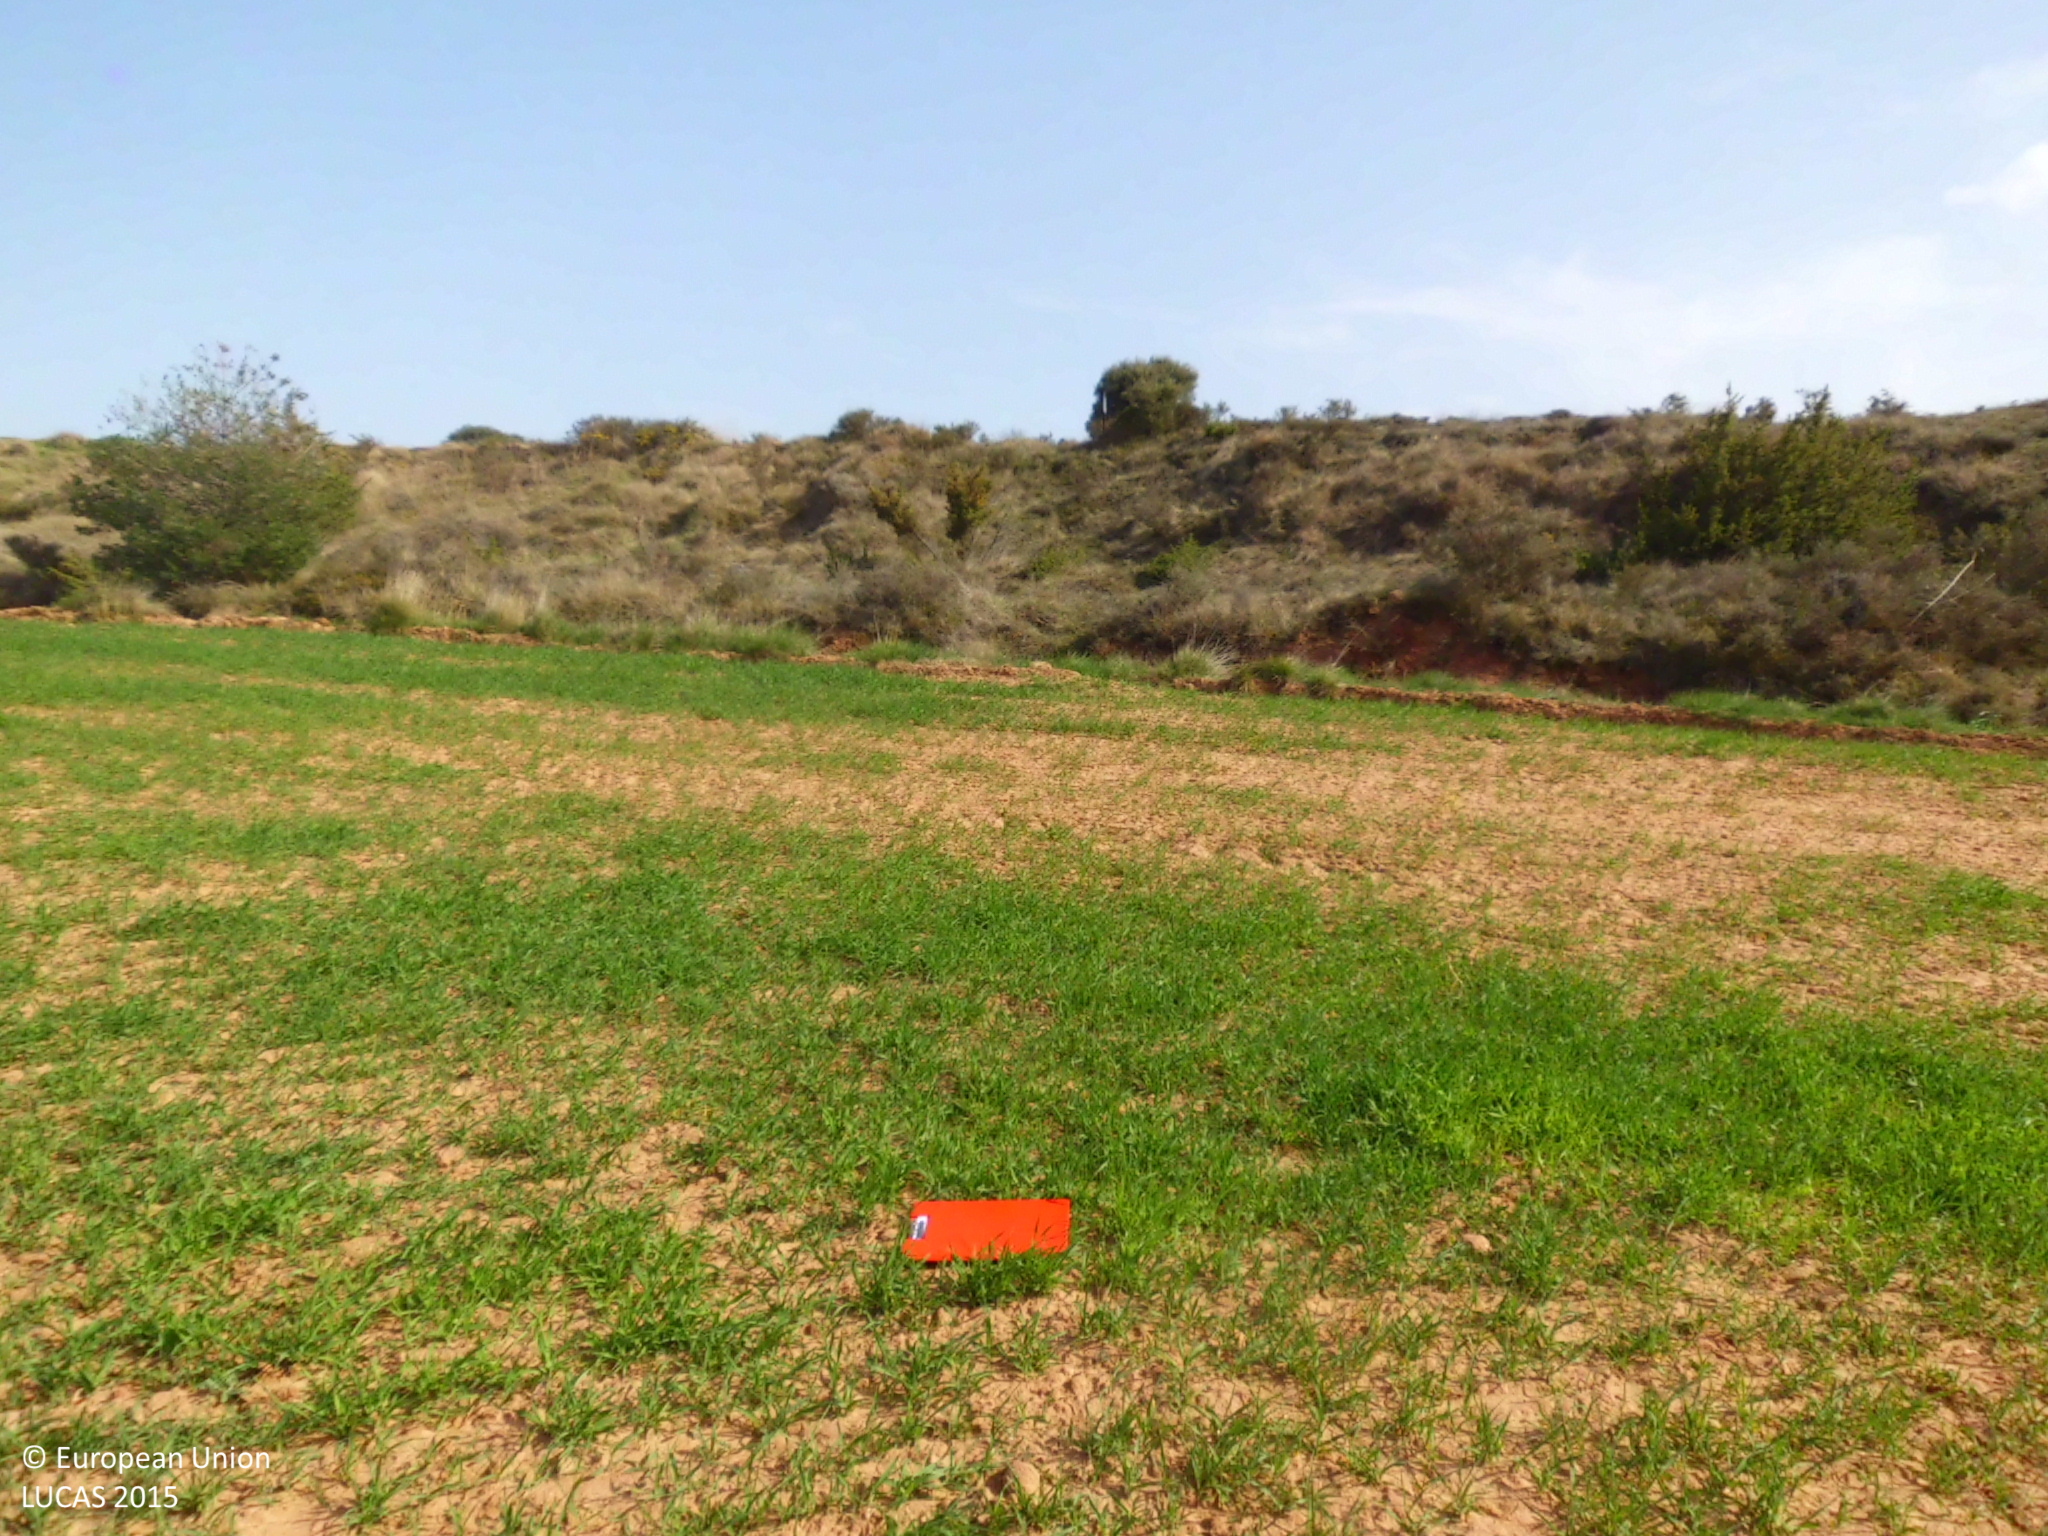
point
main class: Cropland
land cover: Barley
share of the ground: 50 - 75 %
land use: Agriculture (excluding fallow land and kitchen gardens)
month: April
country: ES
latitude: 42.5962
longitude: -3.4286
